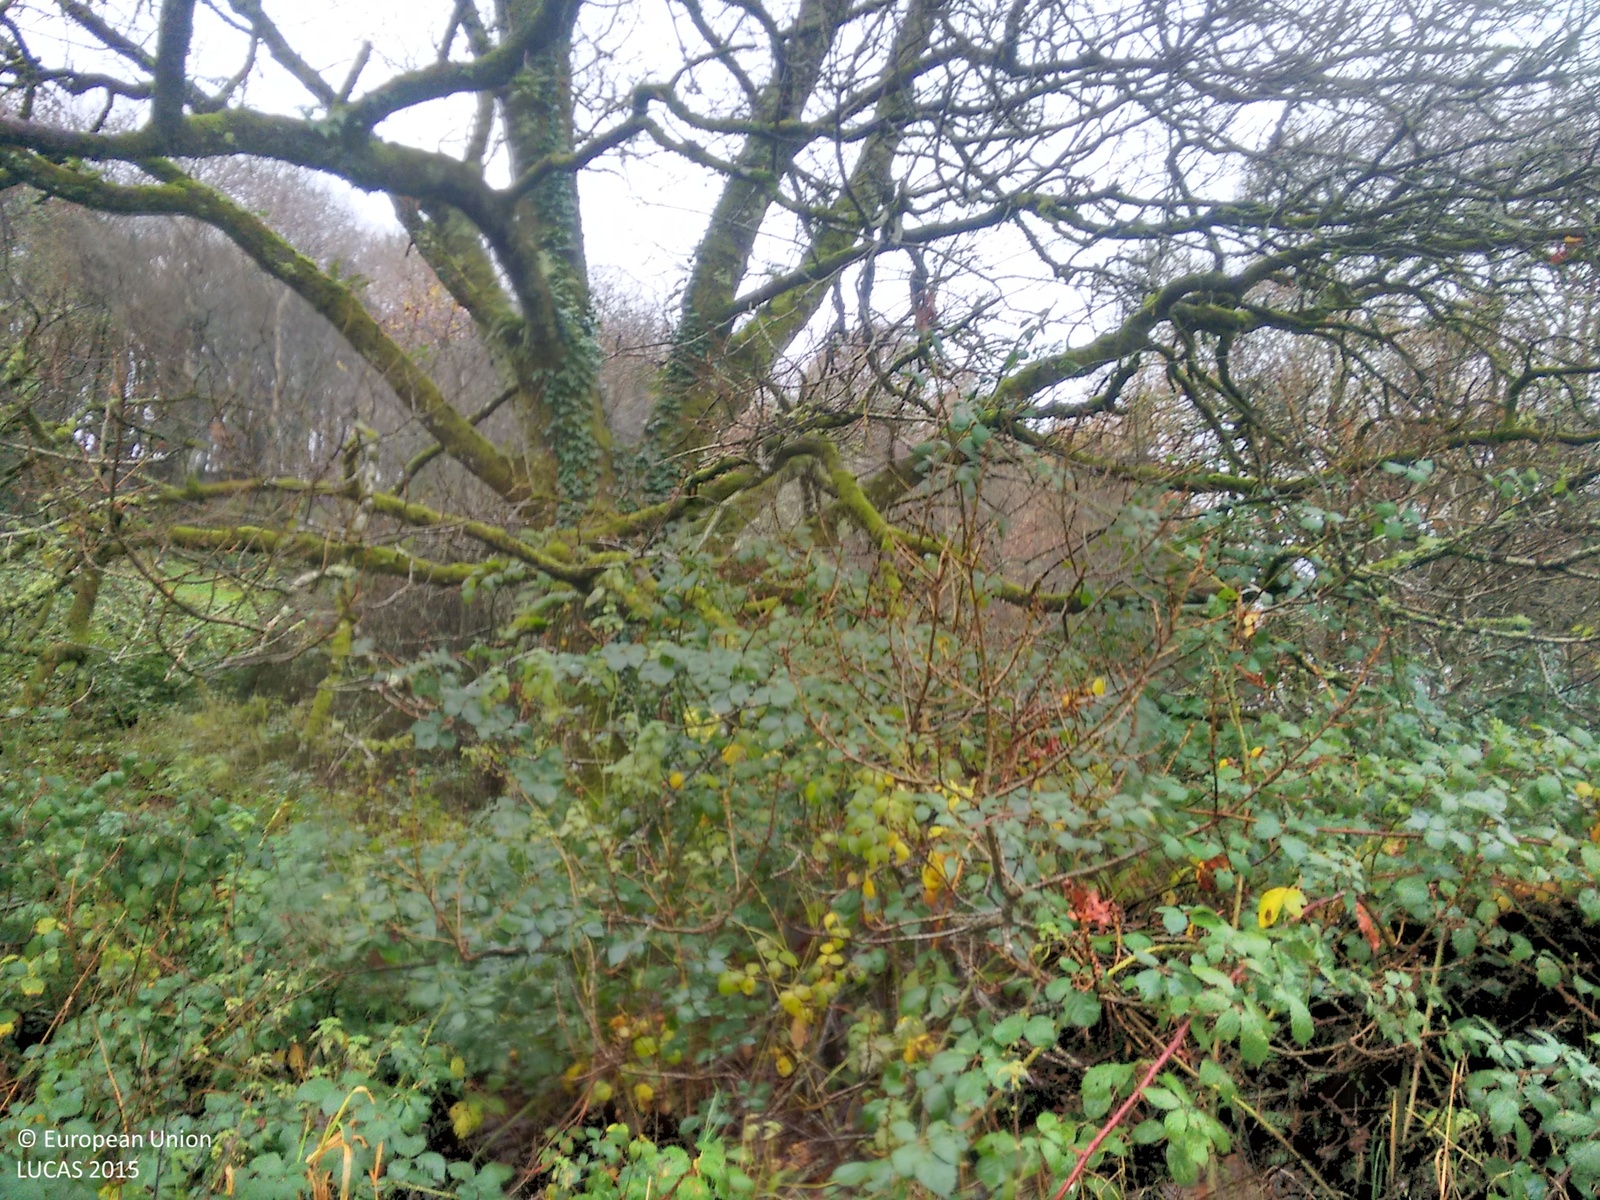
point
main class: Woodland
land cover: Broadleaved woodland
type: exotic forest
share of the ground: > 75 %
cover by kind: broadleaved forest trees 50 %, shrubs 40 %, herbaceous plants 10 %
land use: Agriculture (excluding fallow land and kitchen gardens)
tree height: > 5 m
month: November
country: IE
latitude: 54.0513
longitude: -8.3479
